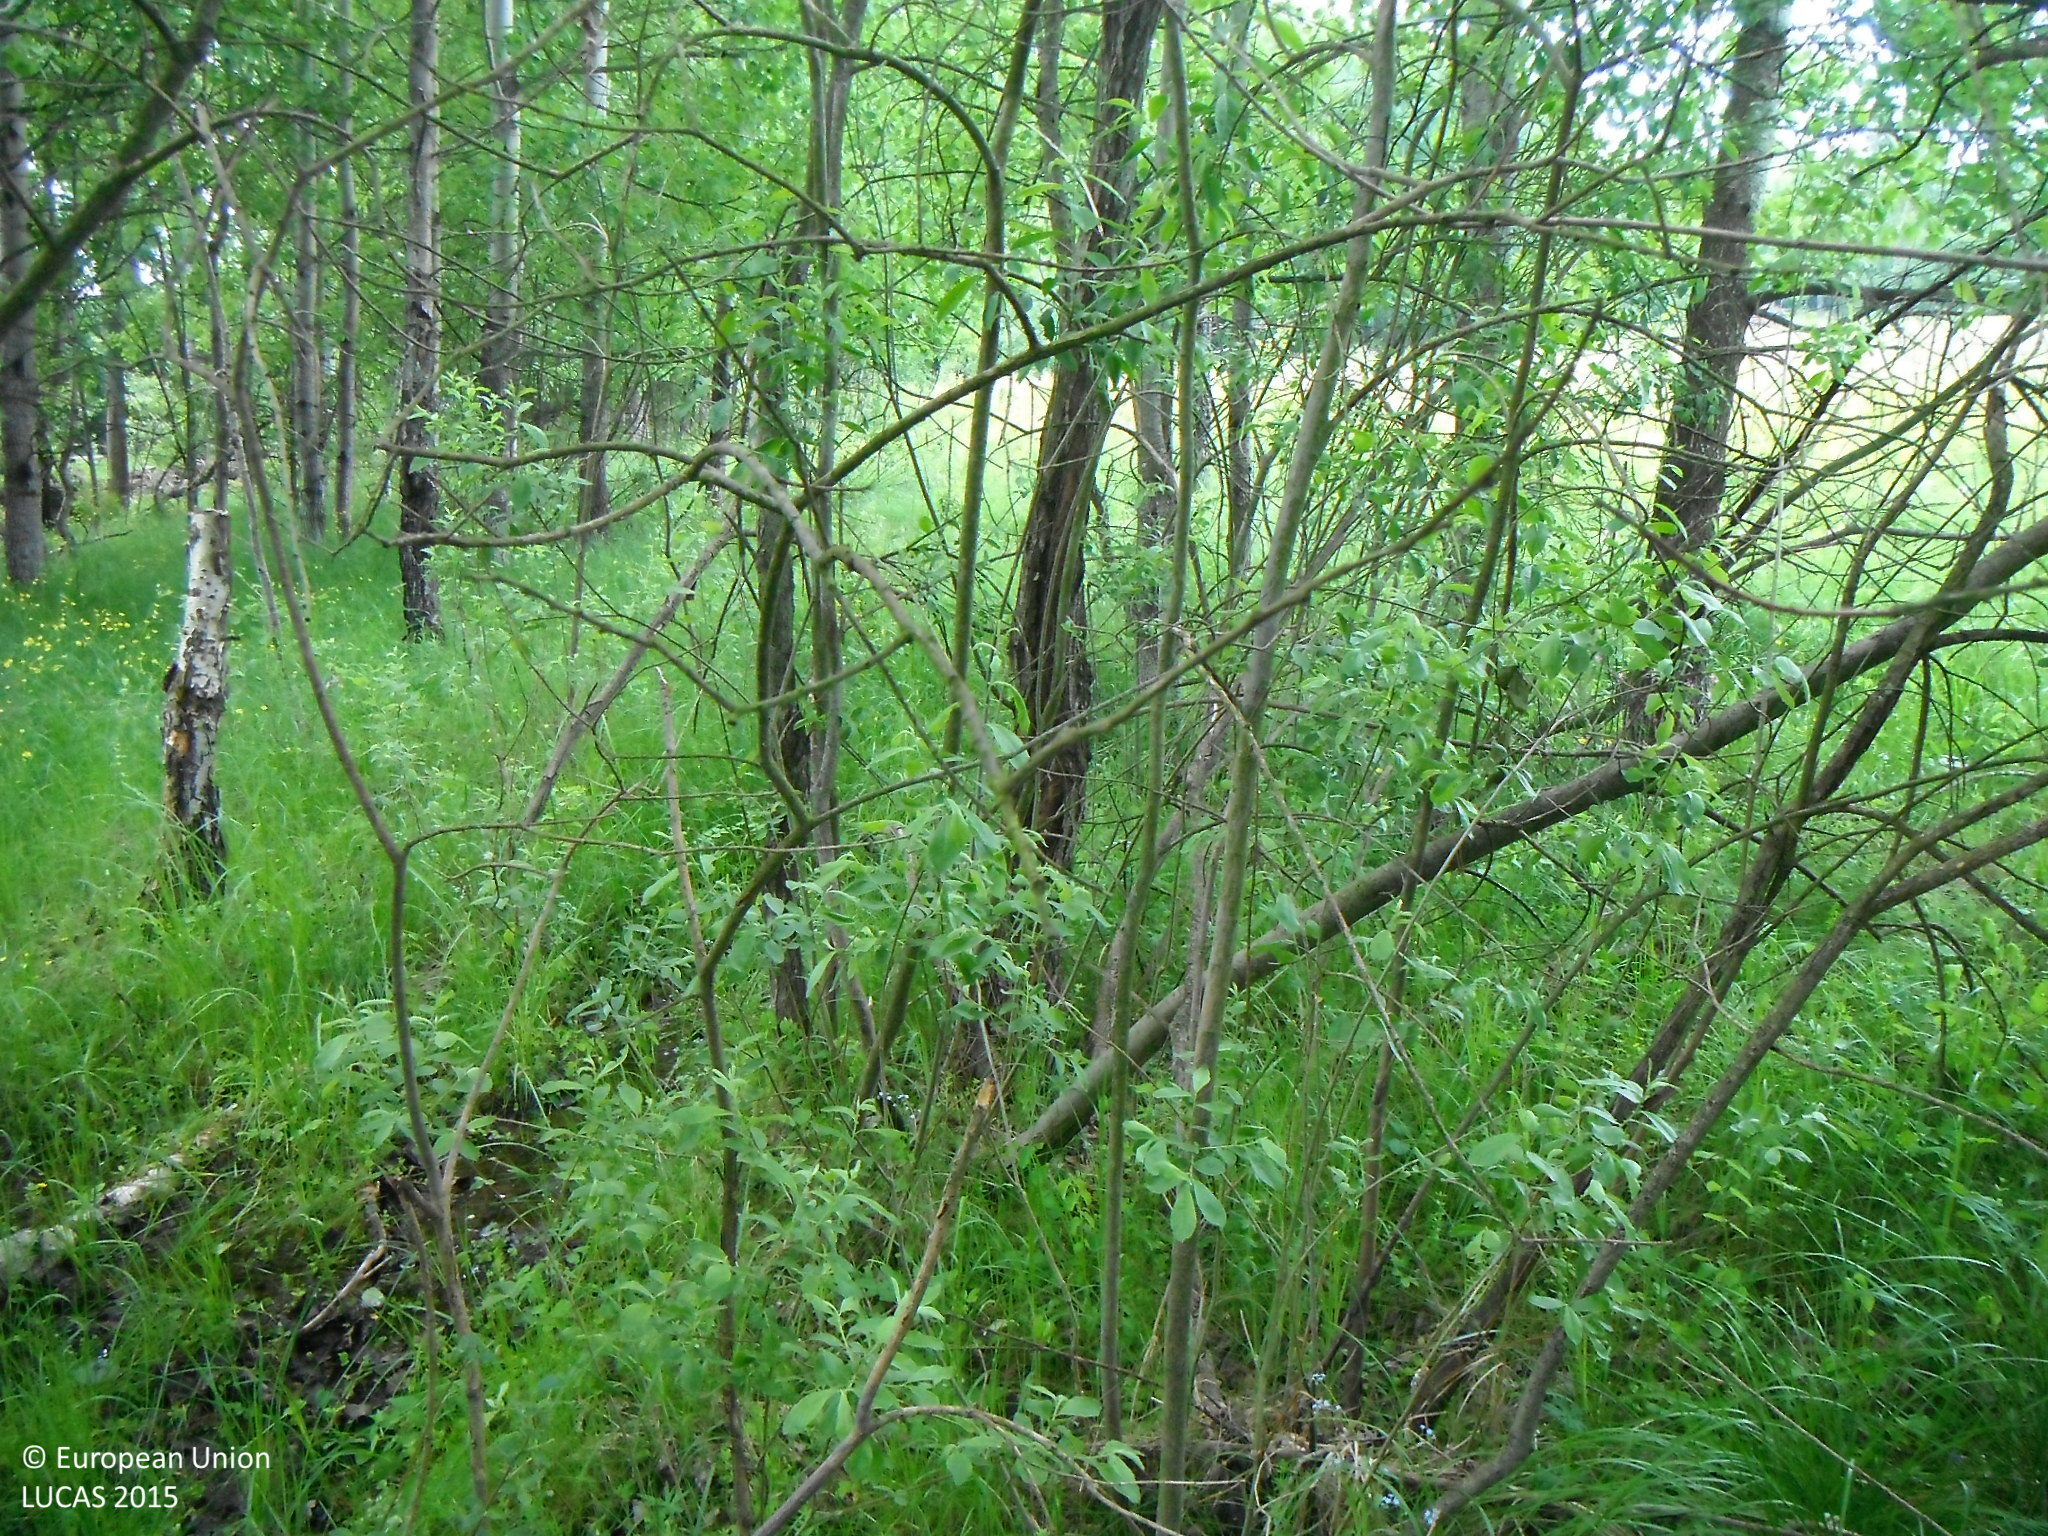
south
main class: Woodland
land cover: Broadleaved woodland
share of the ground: > 75 %
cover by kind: broadleaved forest trees 85 %, herbaceous plants 10 %, shrubs 5 %
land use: Forestry
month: June
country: SK
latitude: 48.4912
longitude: 19.4012
